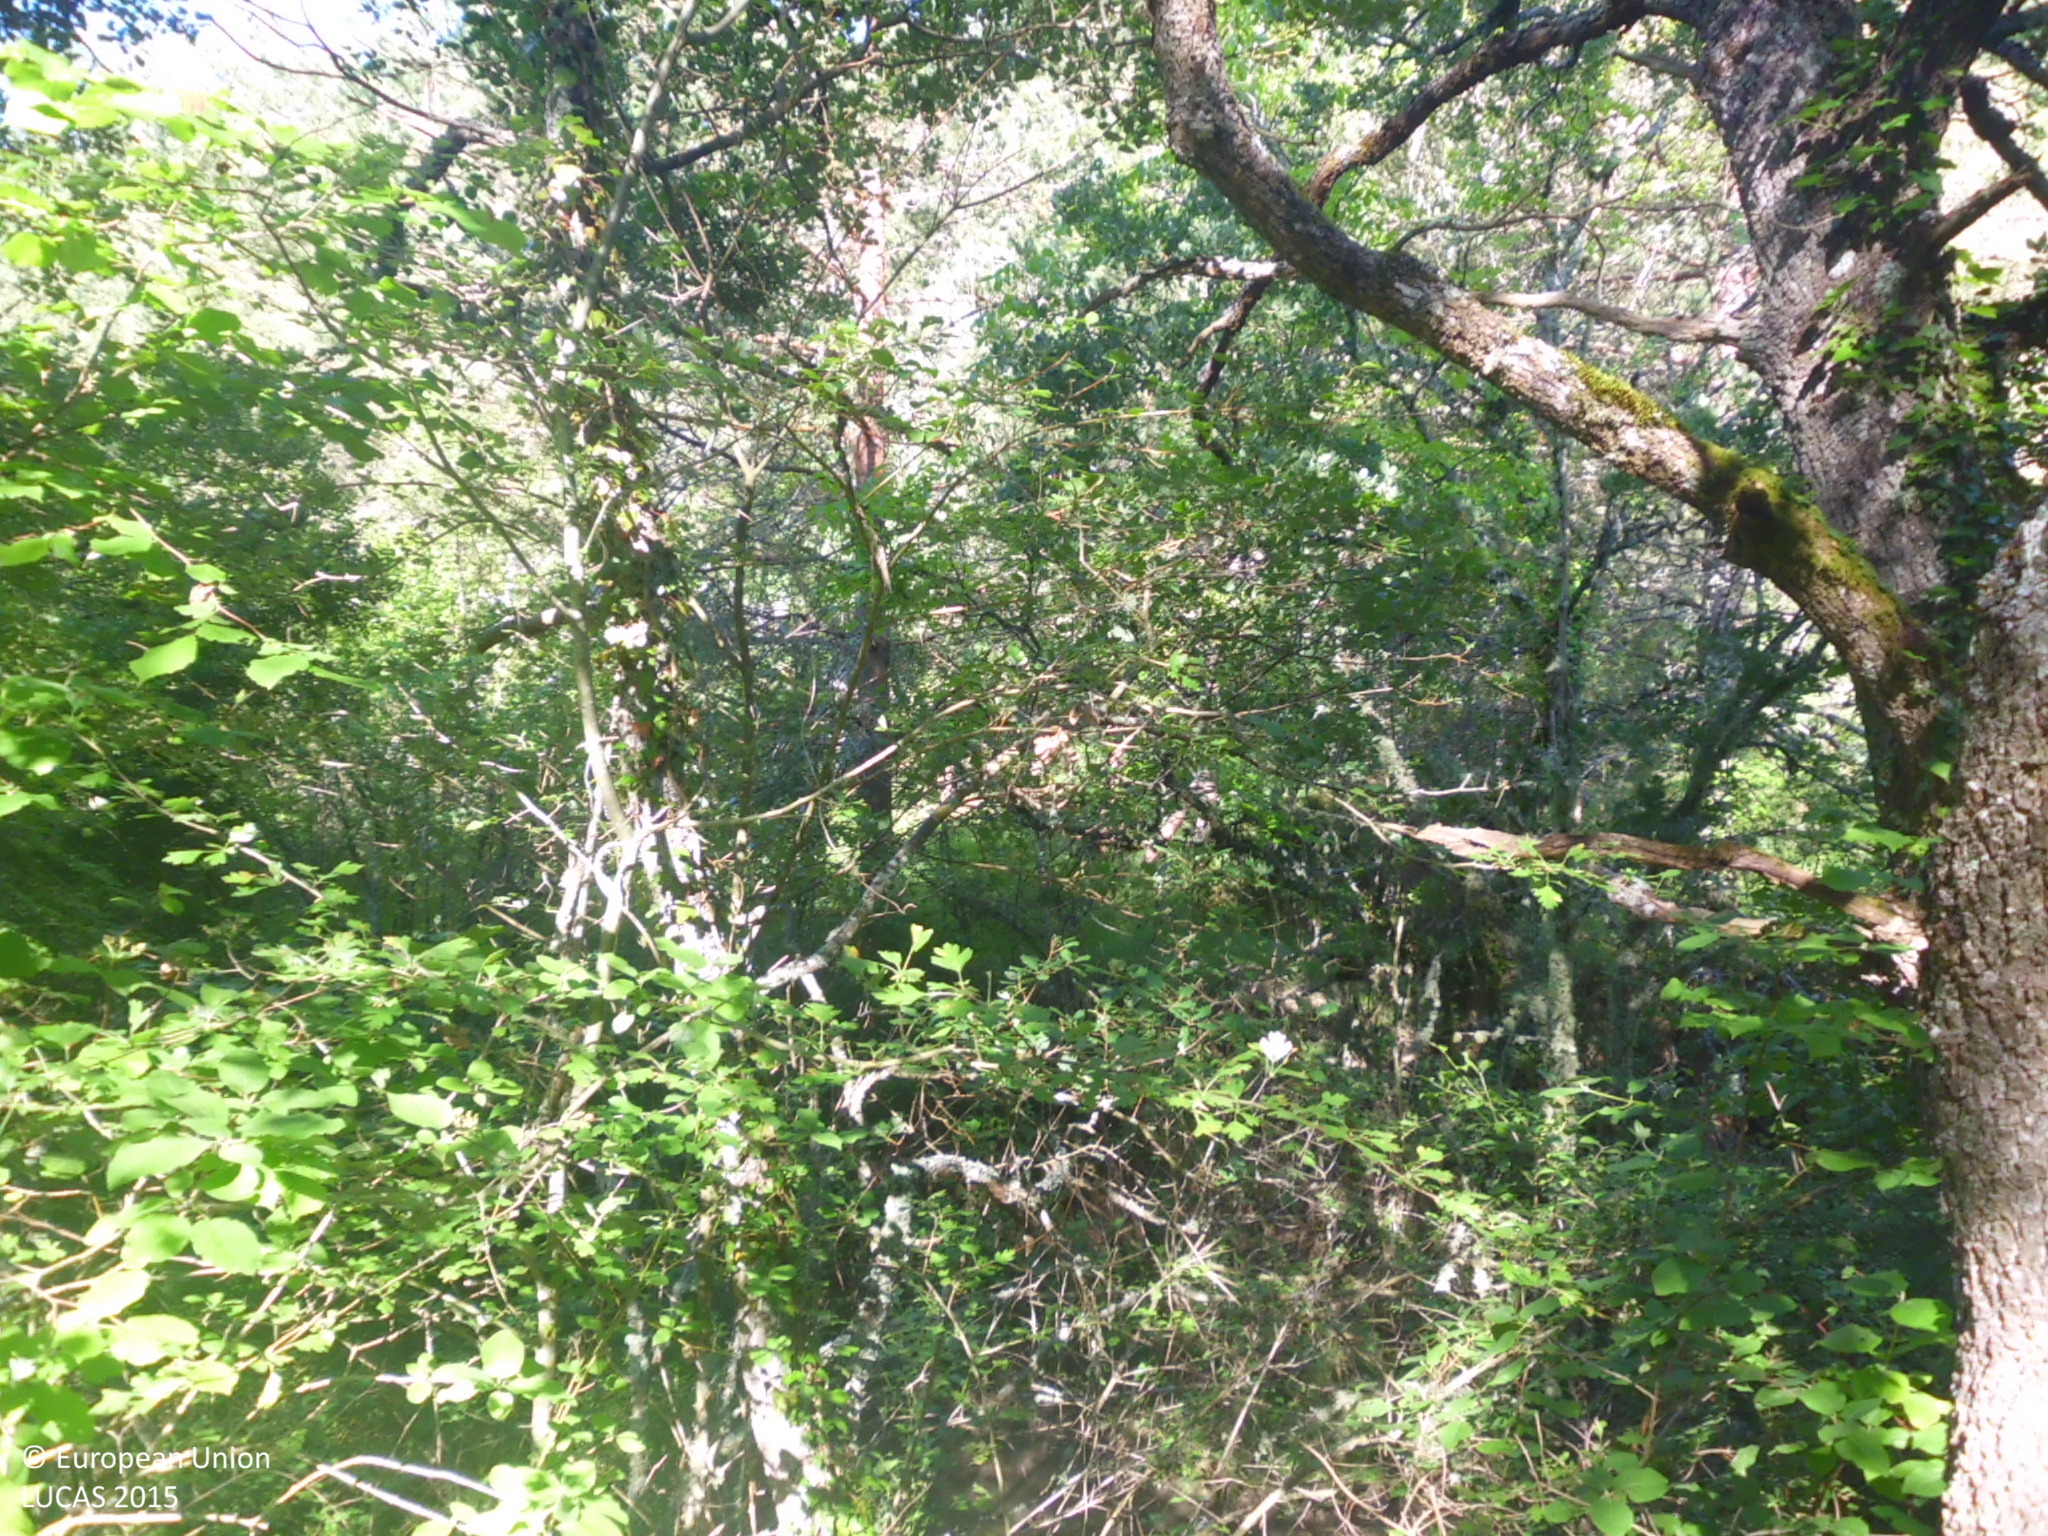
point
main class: Woodland
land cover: Pine dominated mixed woodland
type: coniferous forest of the mediterranean region
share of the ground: 50 - 75 %
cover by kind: coniferous forest trees 40 %, broadleaved forest trees 25 %, herbaceous plants 20 %, shrubs 15 %
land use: Forestry
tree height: > 5 m
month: June
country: ES
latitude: 42.8991
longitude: -3.3488
